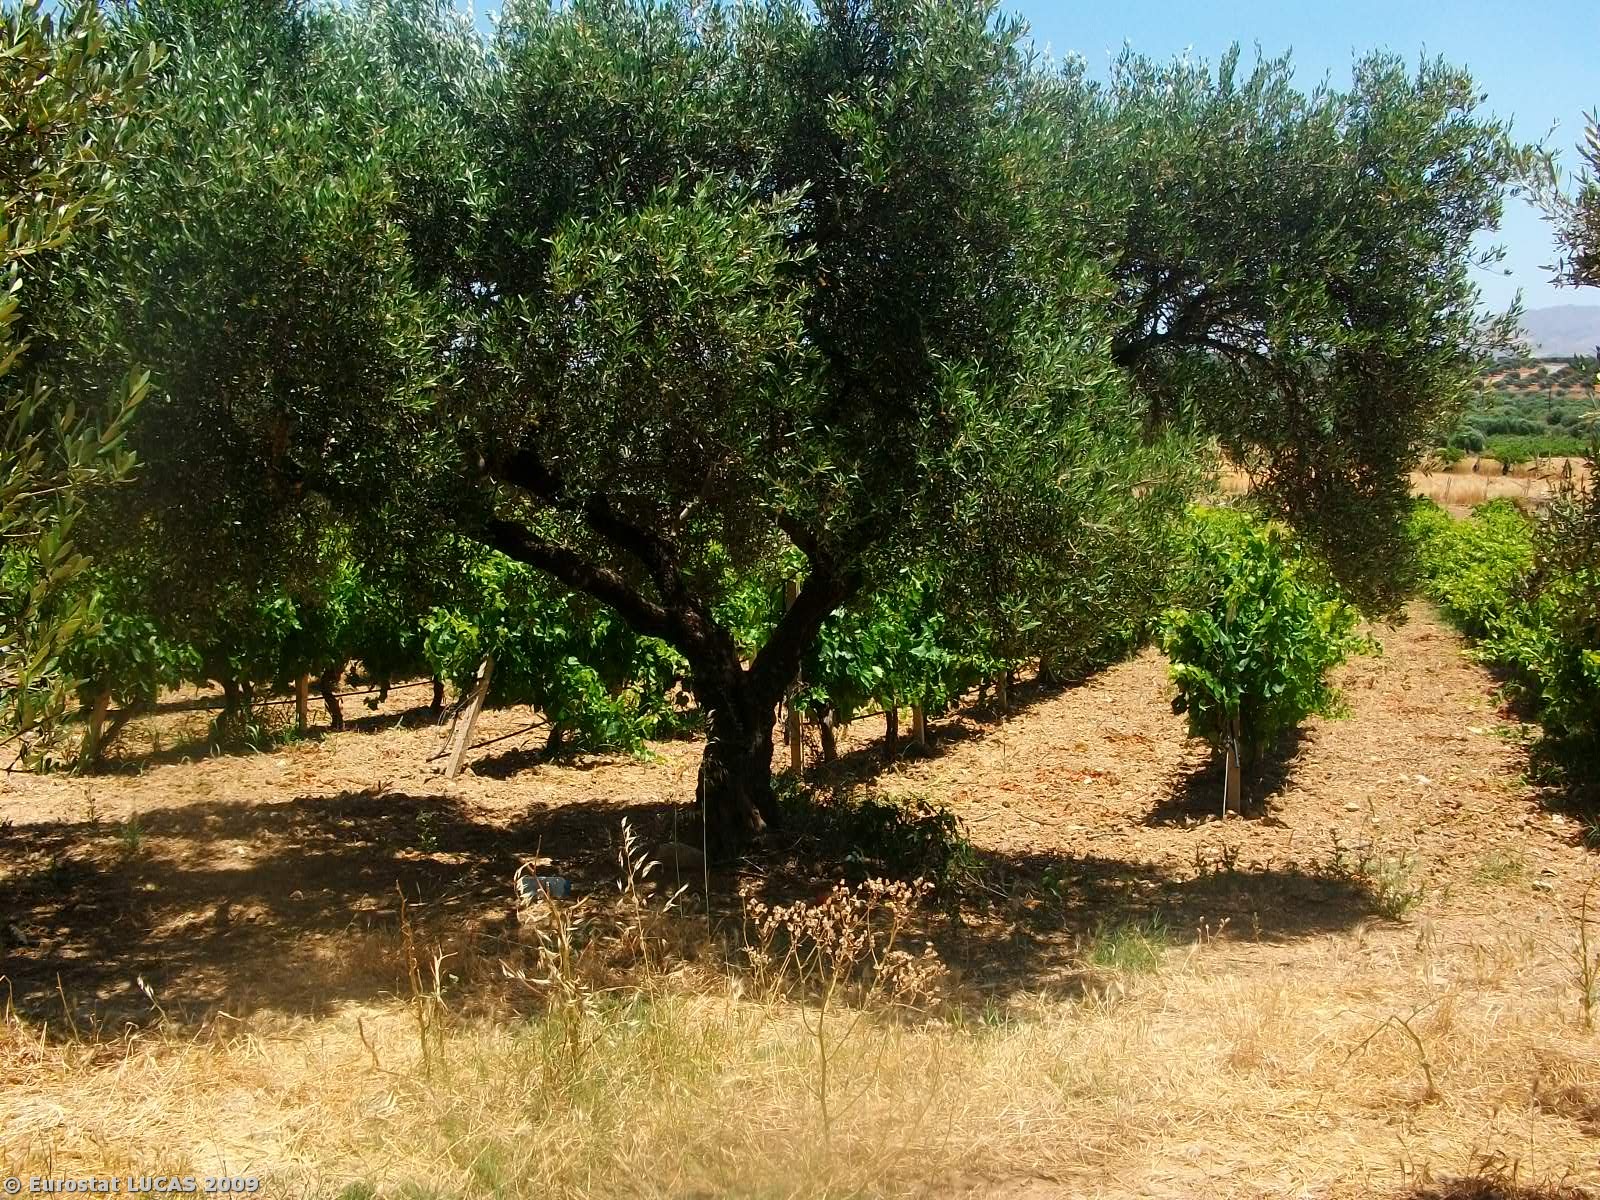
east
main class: Cropland
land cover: Olive groves
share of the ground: > 75 %
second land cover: Bare land
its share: > 75 %
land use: Agriculture (excluding fallow land and kitchen gardens)
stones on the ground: 10 - 25 %
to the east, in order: Olive groves; Bare land; Vineyards; Bare land; Lines of trees; Paved roads, cycling and walking lanes; Grass margins; Olive groves; Bare land; Abandoned hedges; Olive groves; Artificial constructions in urban areas; Olive groves; Bare land
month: June
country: GR
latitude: 35.0549
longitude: 25.0181
